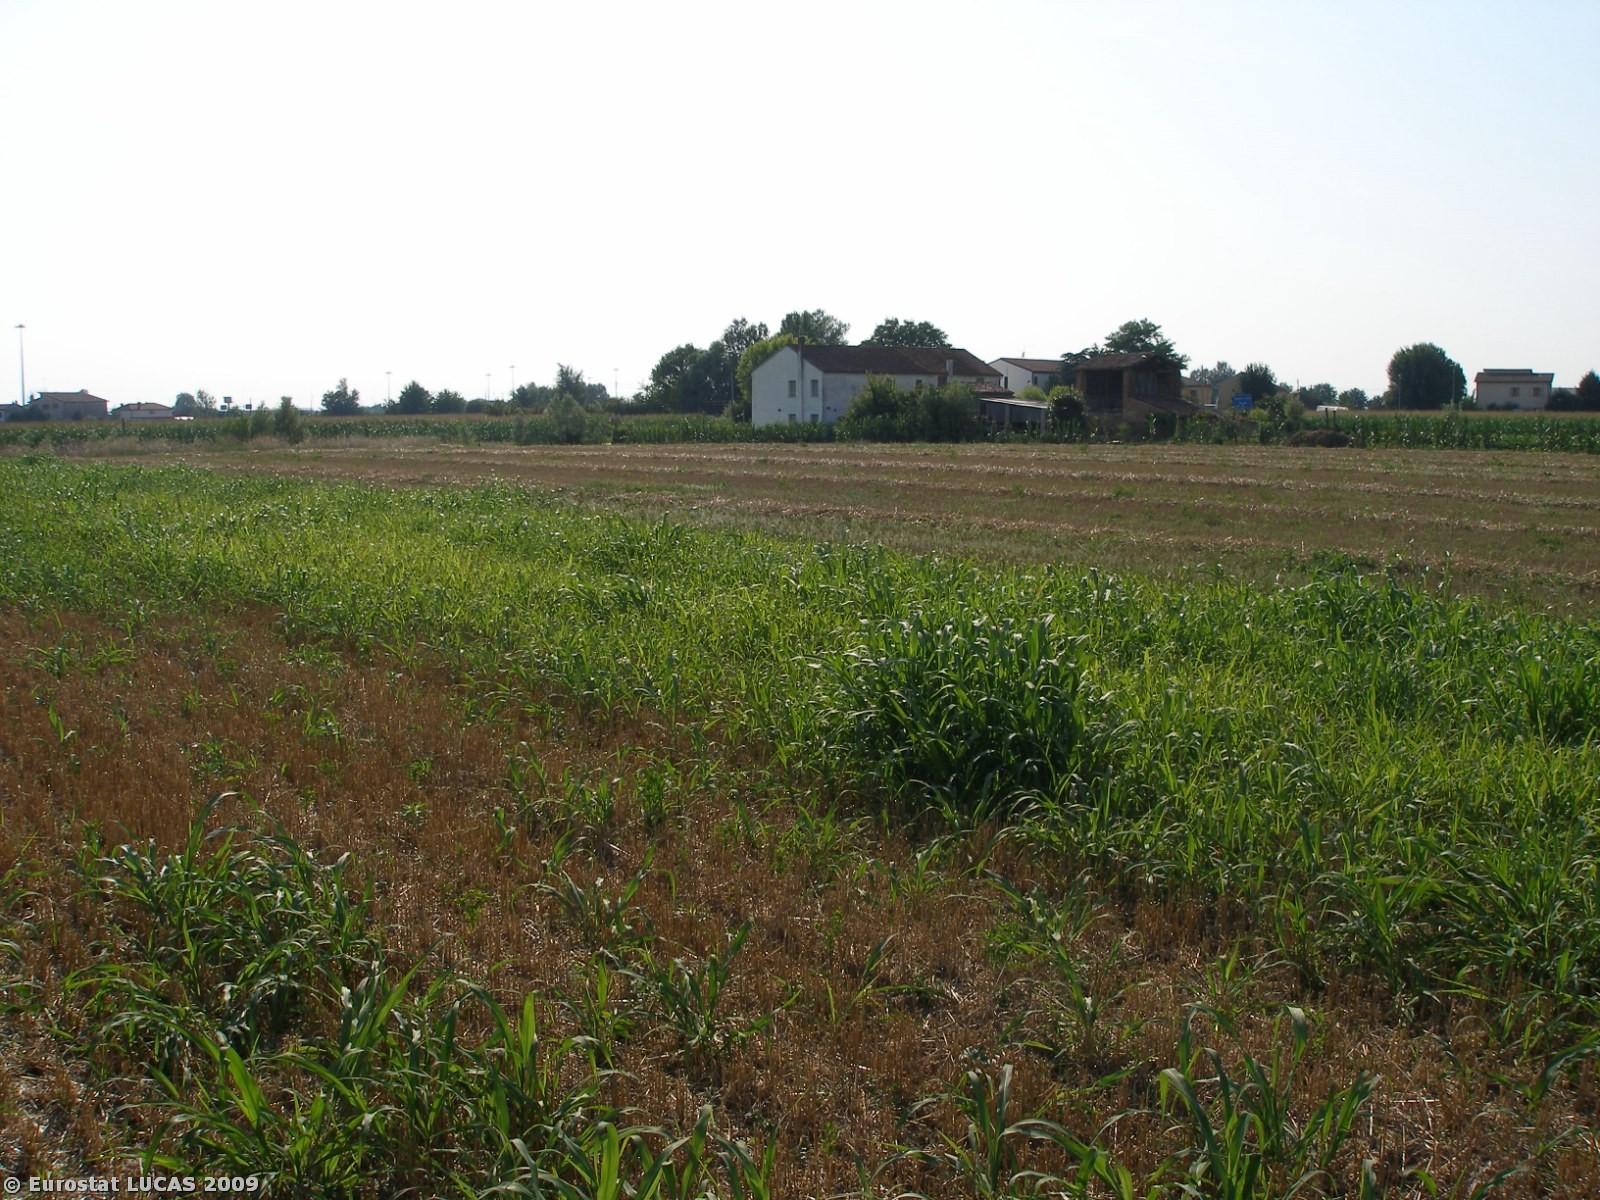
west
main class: Cropland
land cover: Durum wheat
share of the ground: < 10 %
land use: Agriculture (excluding fallow land and kitchen gardens)
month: July
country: IT
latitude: 45.0218
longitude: 11.7101
